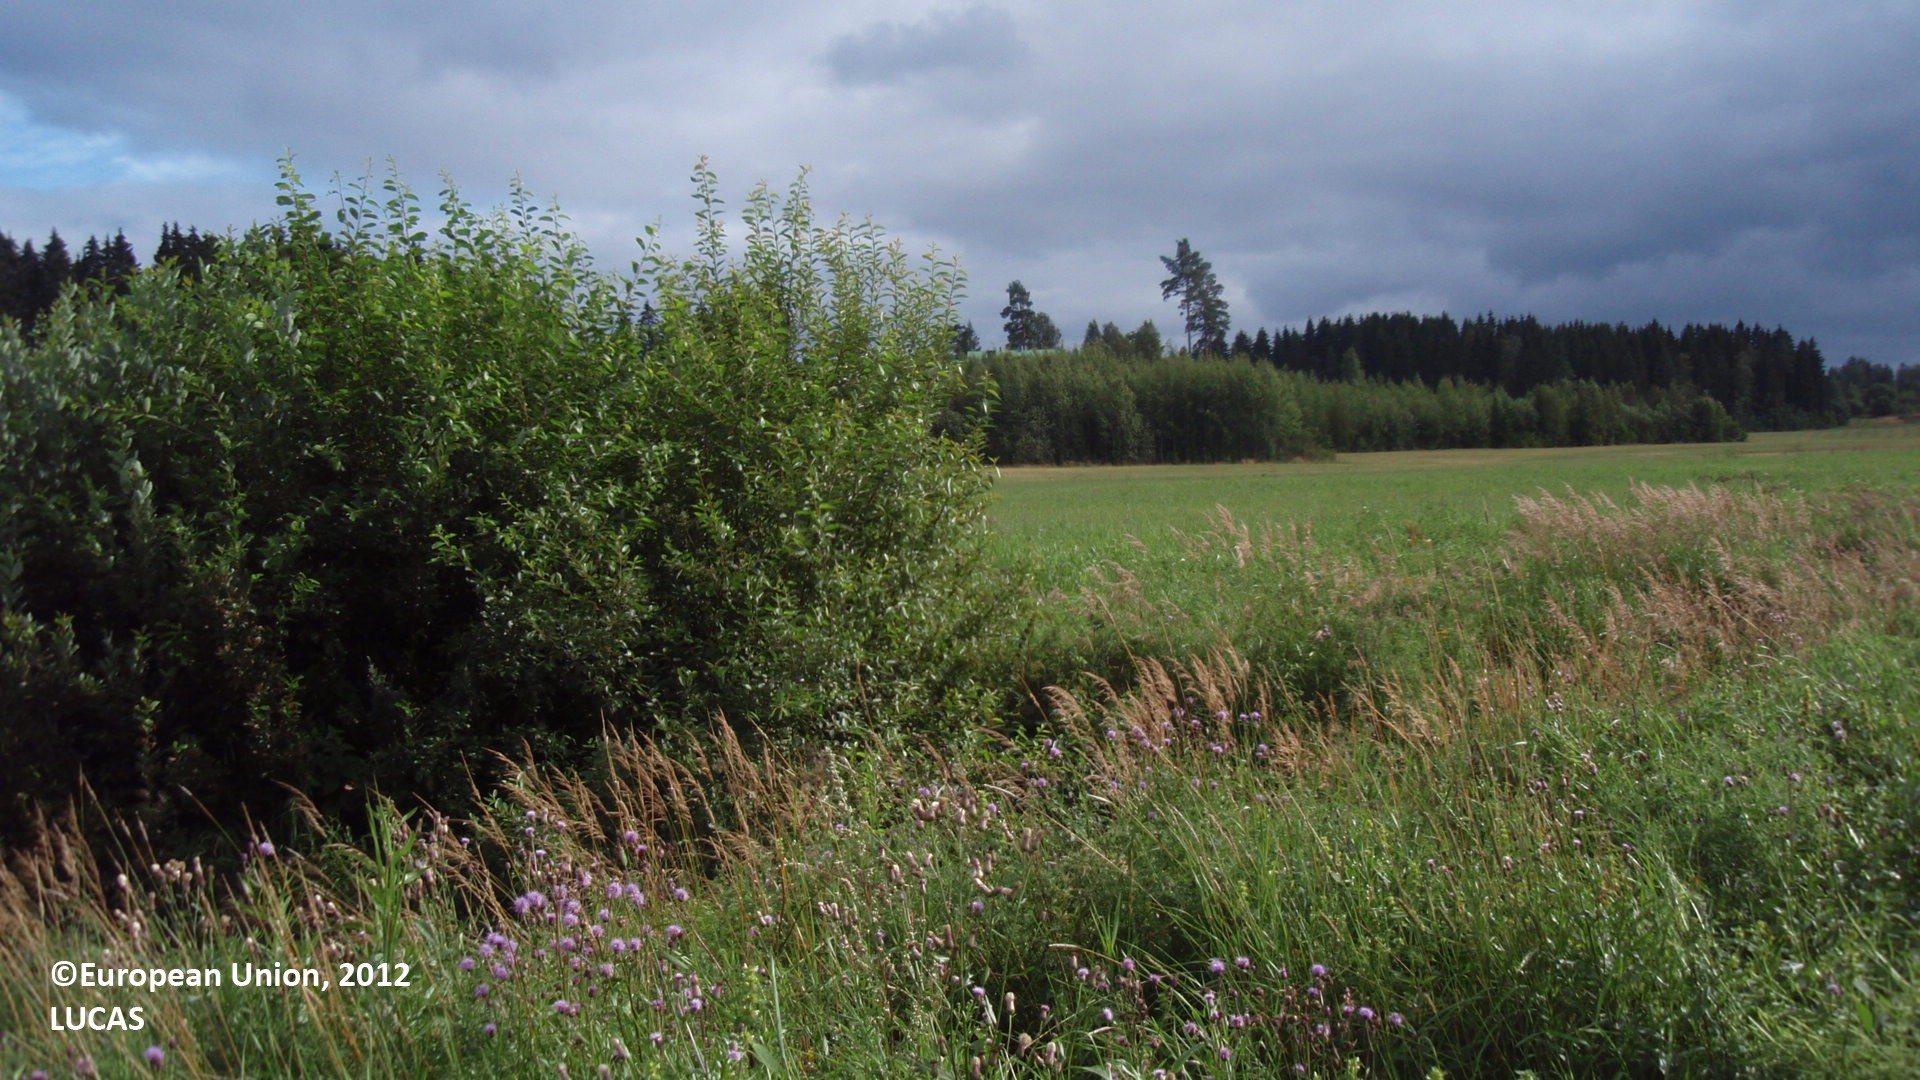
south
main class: Cropland
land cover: Rape and turnip rape
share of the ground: > 75 %
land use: Agriculture (excluding fallow land and kitchen gardens)
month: August
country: FI
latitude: 60.9110
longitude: 27.6119
